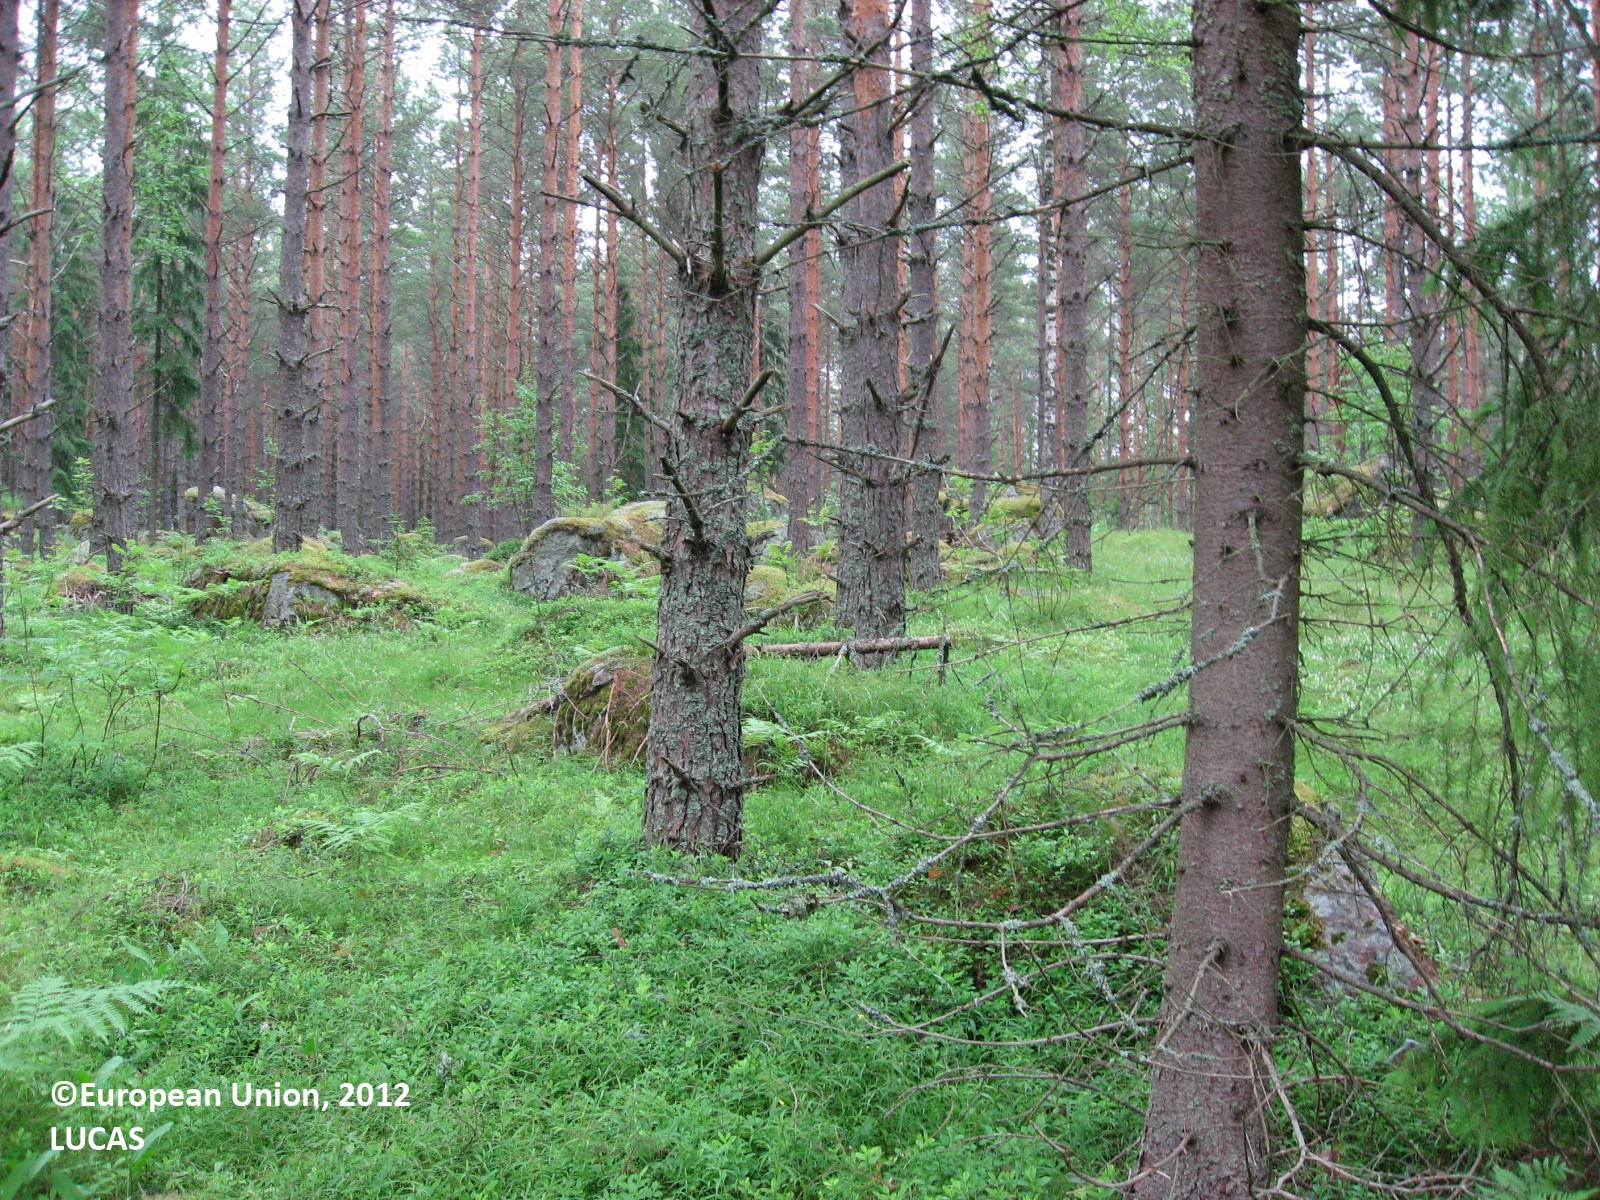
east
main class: Woodland
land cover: Pine dominated coniferous woodland
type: boreal forest
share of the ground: > 75 %
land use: Forestry
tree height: > 5 m
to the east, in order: Pine dominated coniferous woodland; Pine dominated mixed woodland; Ditches and canals; Other mixed woodland
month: June
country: FI
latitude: 60.4825
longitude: 26.2524
